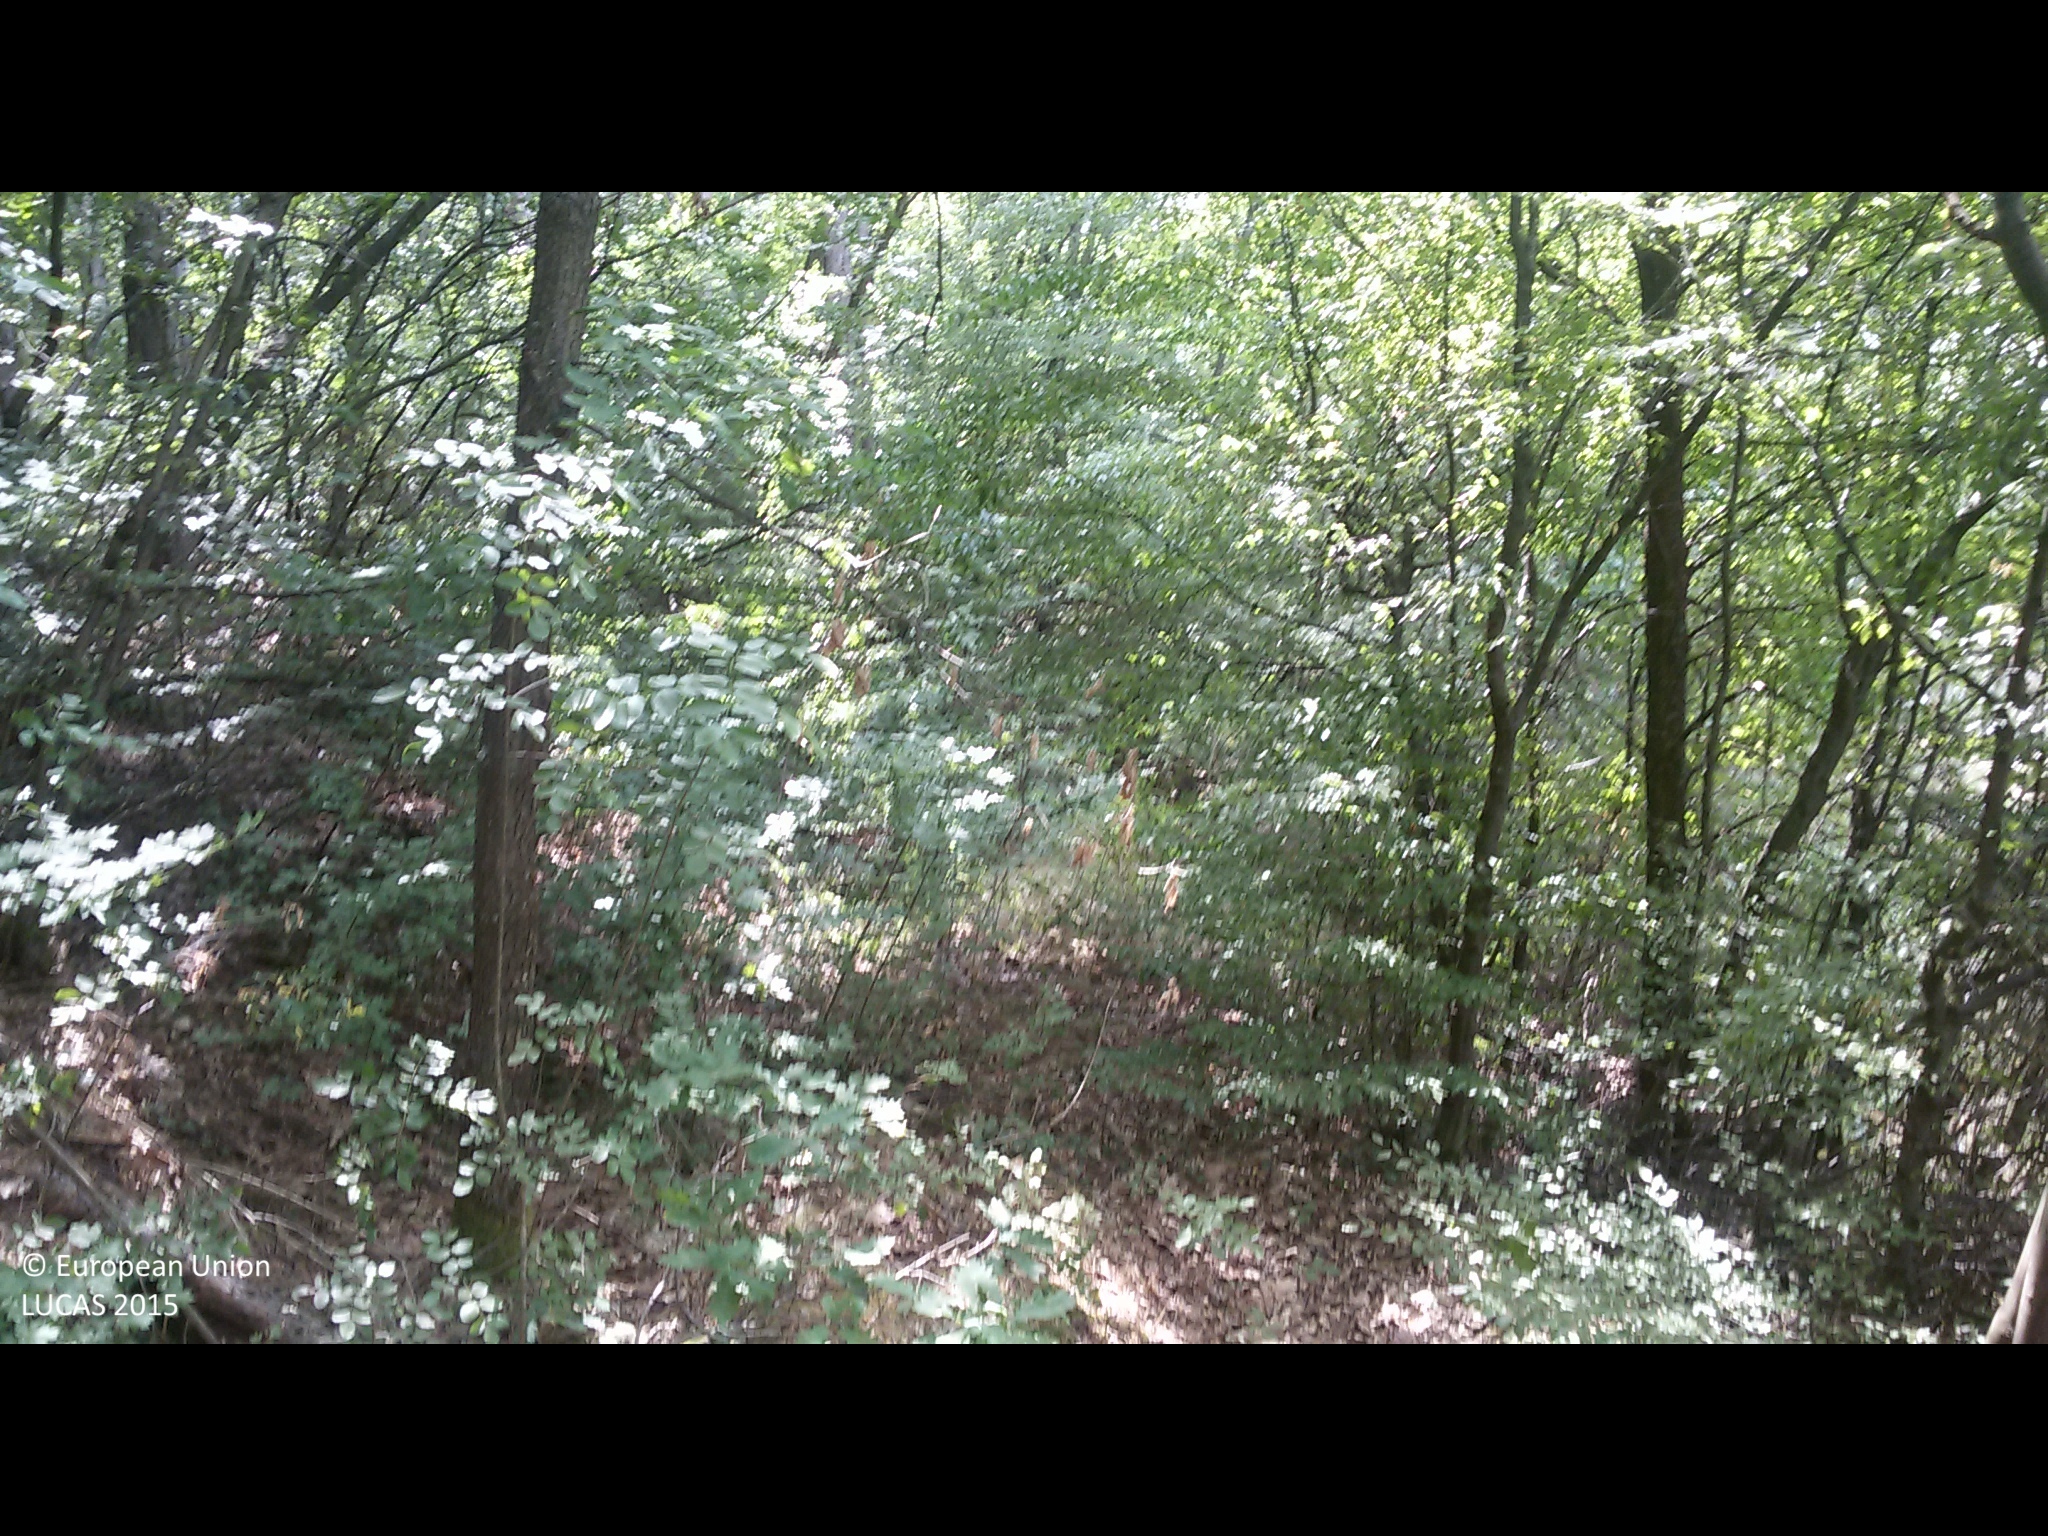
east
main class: Woodland
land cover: Broadleaved woodland
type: mesophytic deciduous forest
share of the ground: > 75 %
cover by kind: broadleaved forest trees 95 %, coniferous forest trees 5 %
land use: Forestry
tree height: > 5 m
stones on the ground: < 10 %
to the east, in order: Broadleaved woodland; Other coniferous woodland
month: August
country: BG
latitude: 42.0327
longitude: 23.1306
